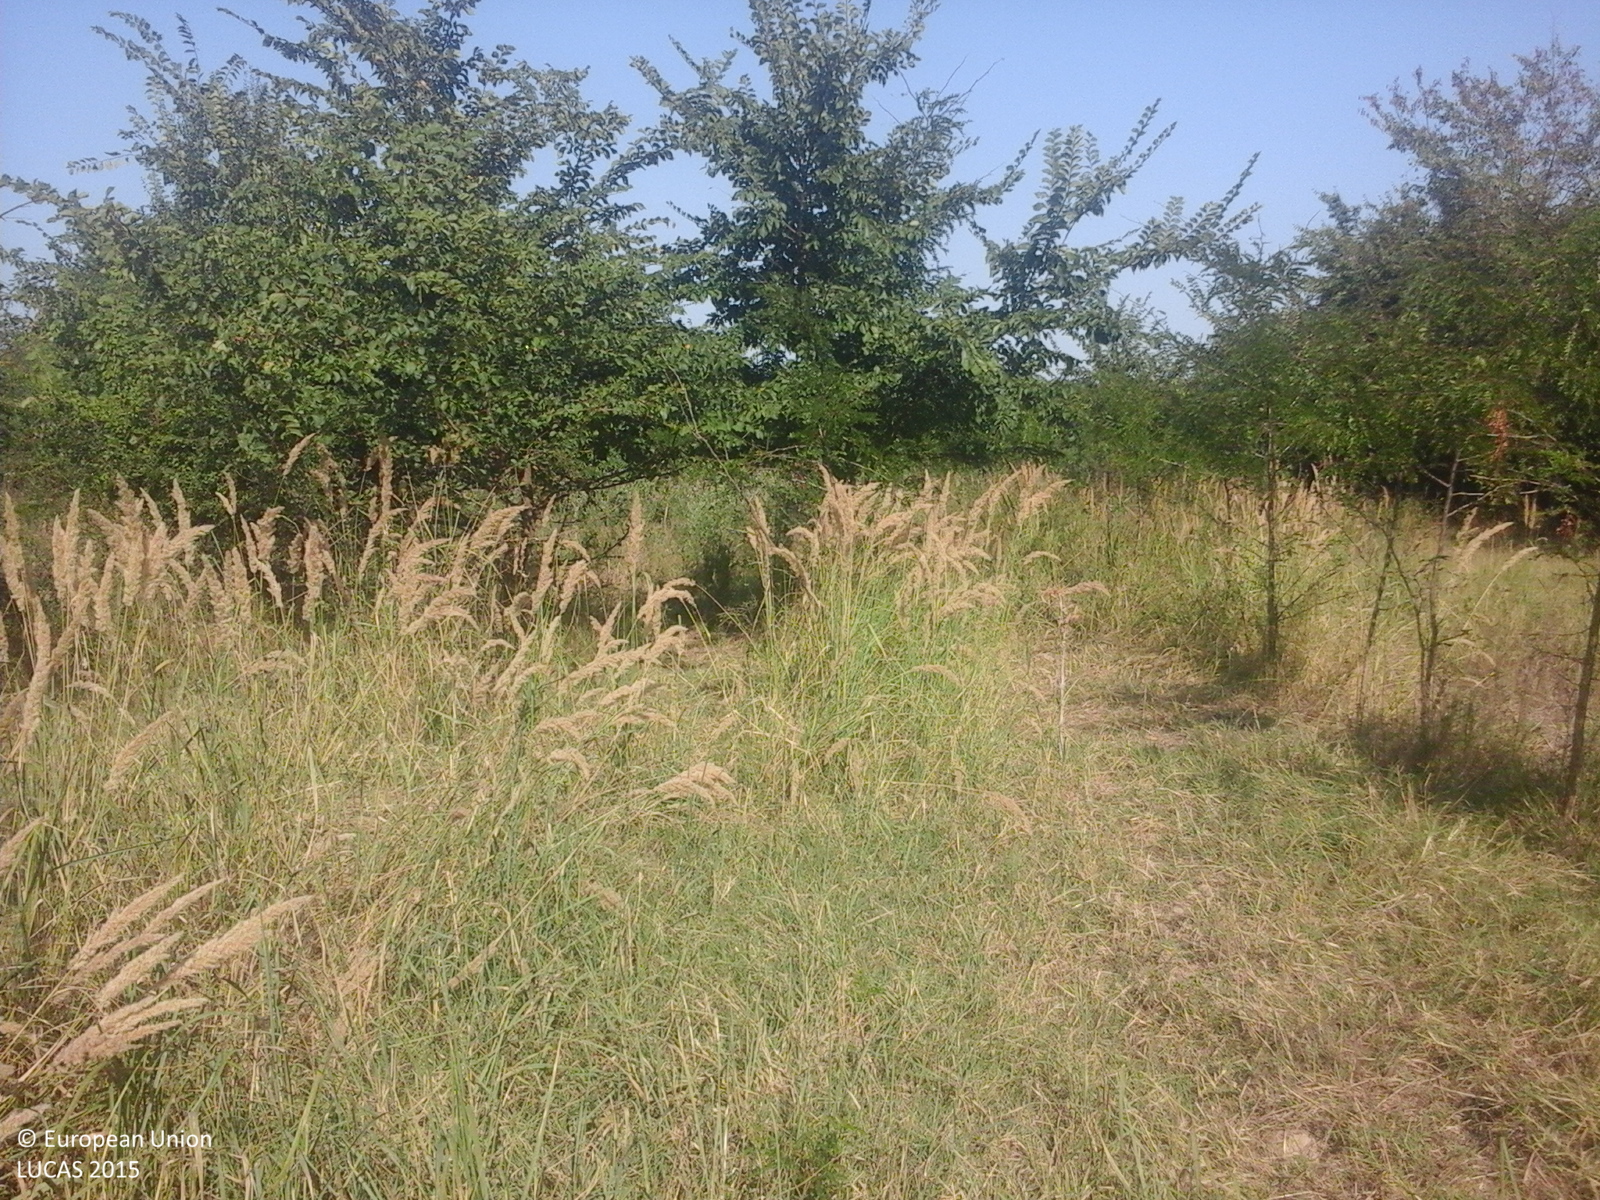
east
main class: Grassland
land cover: Grassland with sparse tree/shrub cover
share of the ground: > 75 %
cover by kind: herbaceous plants 90 %, broadleaved forest trees 5 %, shrubs 5 %
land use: Agriculture (excluding fallow land and kitchen gardens)
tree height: < 5 m
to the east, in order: Grassland with sparse tree/shrub cover; Abandoned hedges; Grassland with sparse tree/shrub cover; Broadleaved woodland; Tracks; Broadleaved woodland
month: July
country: RO
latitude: 44.6319
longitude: 27.6320
